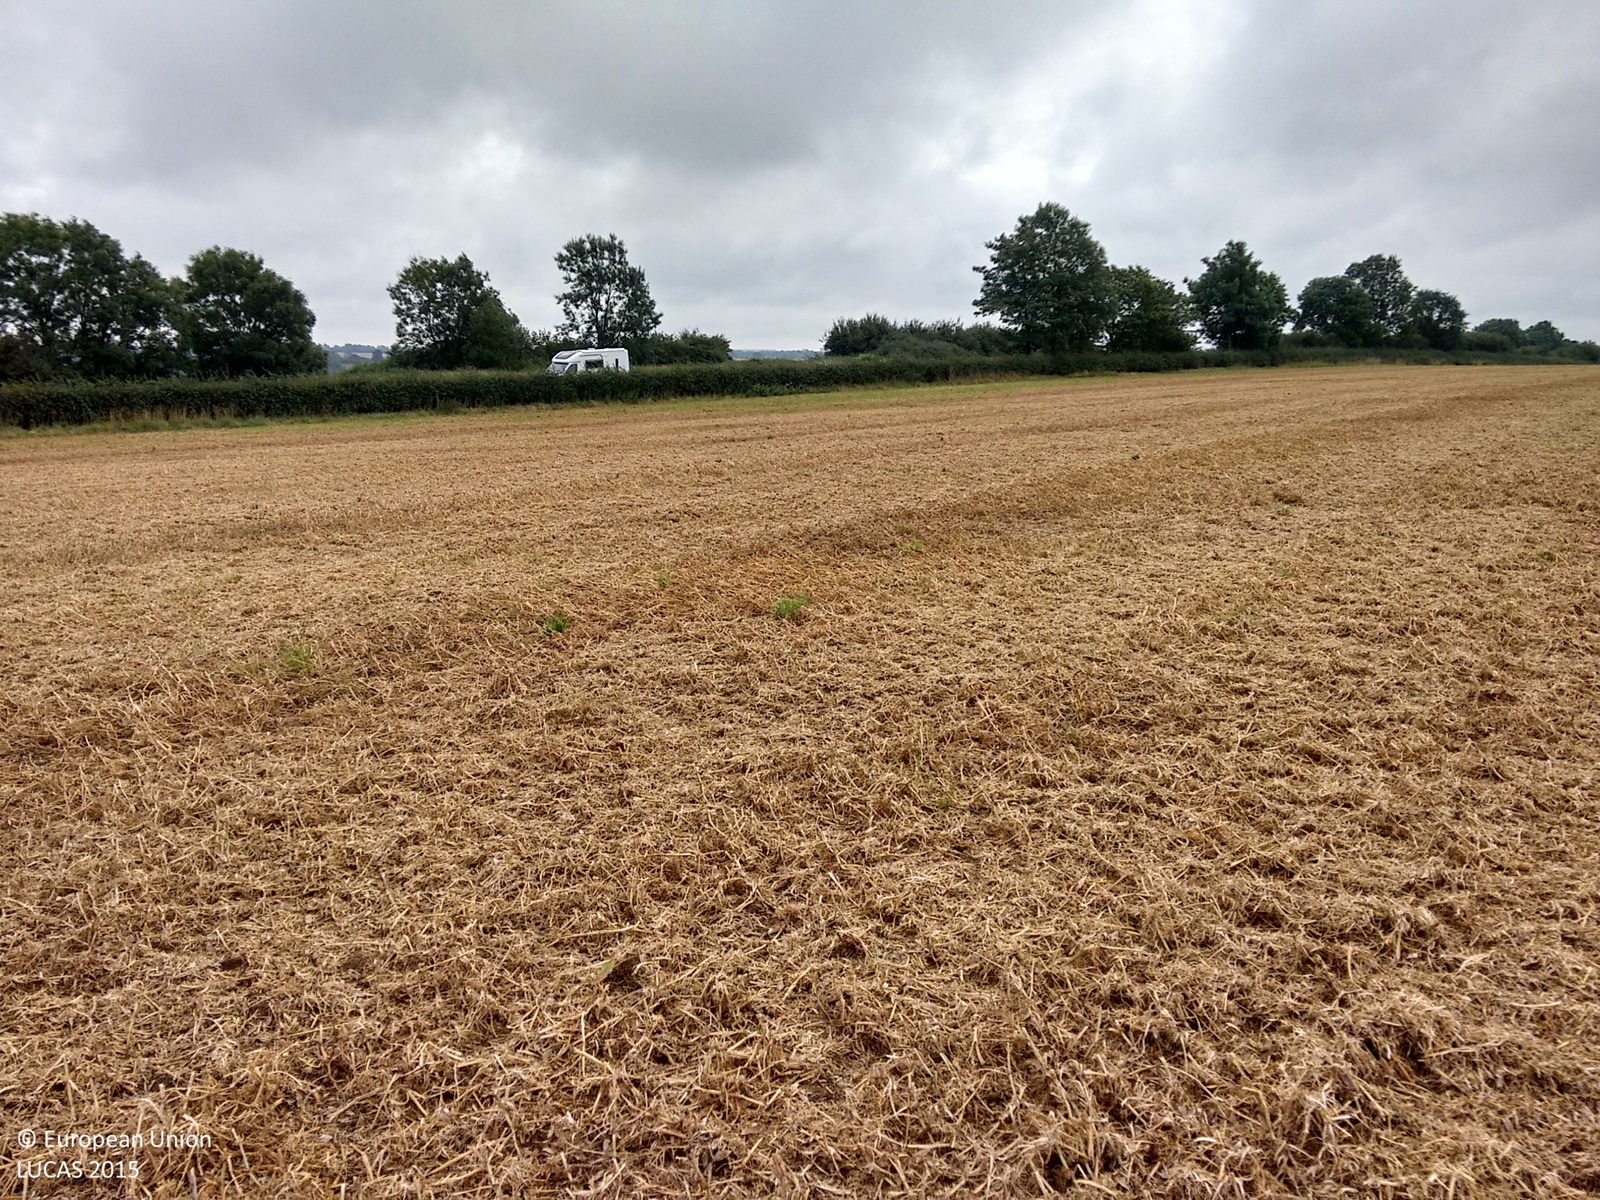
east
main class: Cropland
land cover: Dry pulses
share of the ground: > 75 %
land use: Agriculture (excluding fallow land and kitchen gardens)
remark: Harvested field
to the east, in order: Dry pulses; Grass margins; Managed hedges; Grass margins; Paved roads, cycling and walking lanes; Grass margins; Single bushes/trees; Fences; Grassland without tree/shrub cover; Common wheat
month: September
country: GB
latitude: 52.4734
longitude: -1.2807
